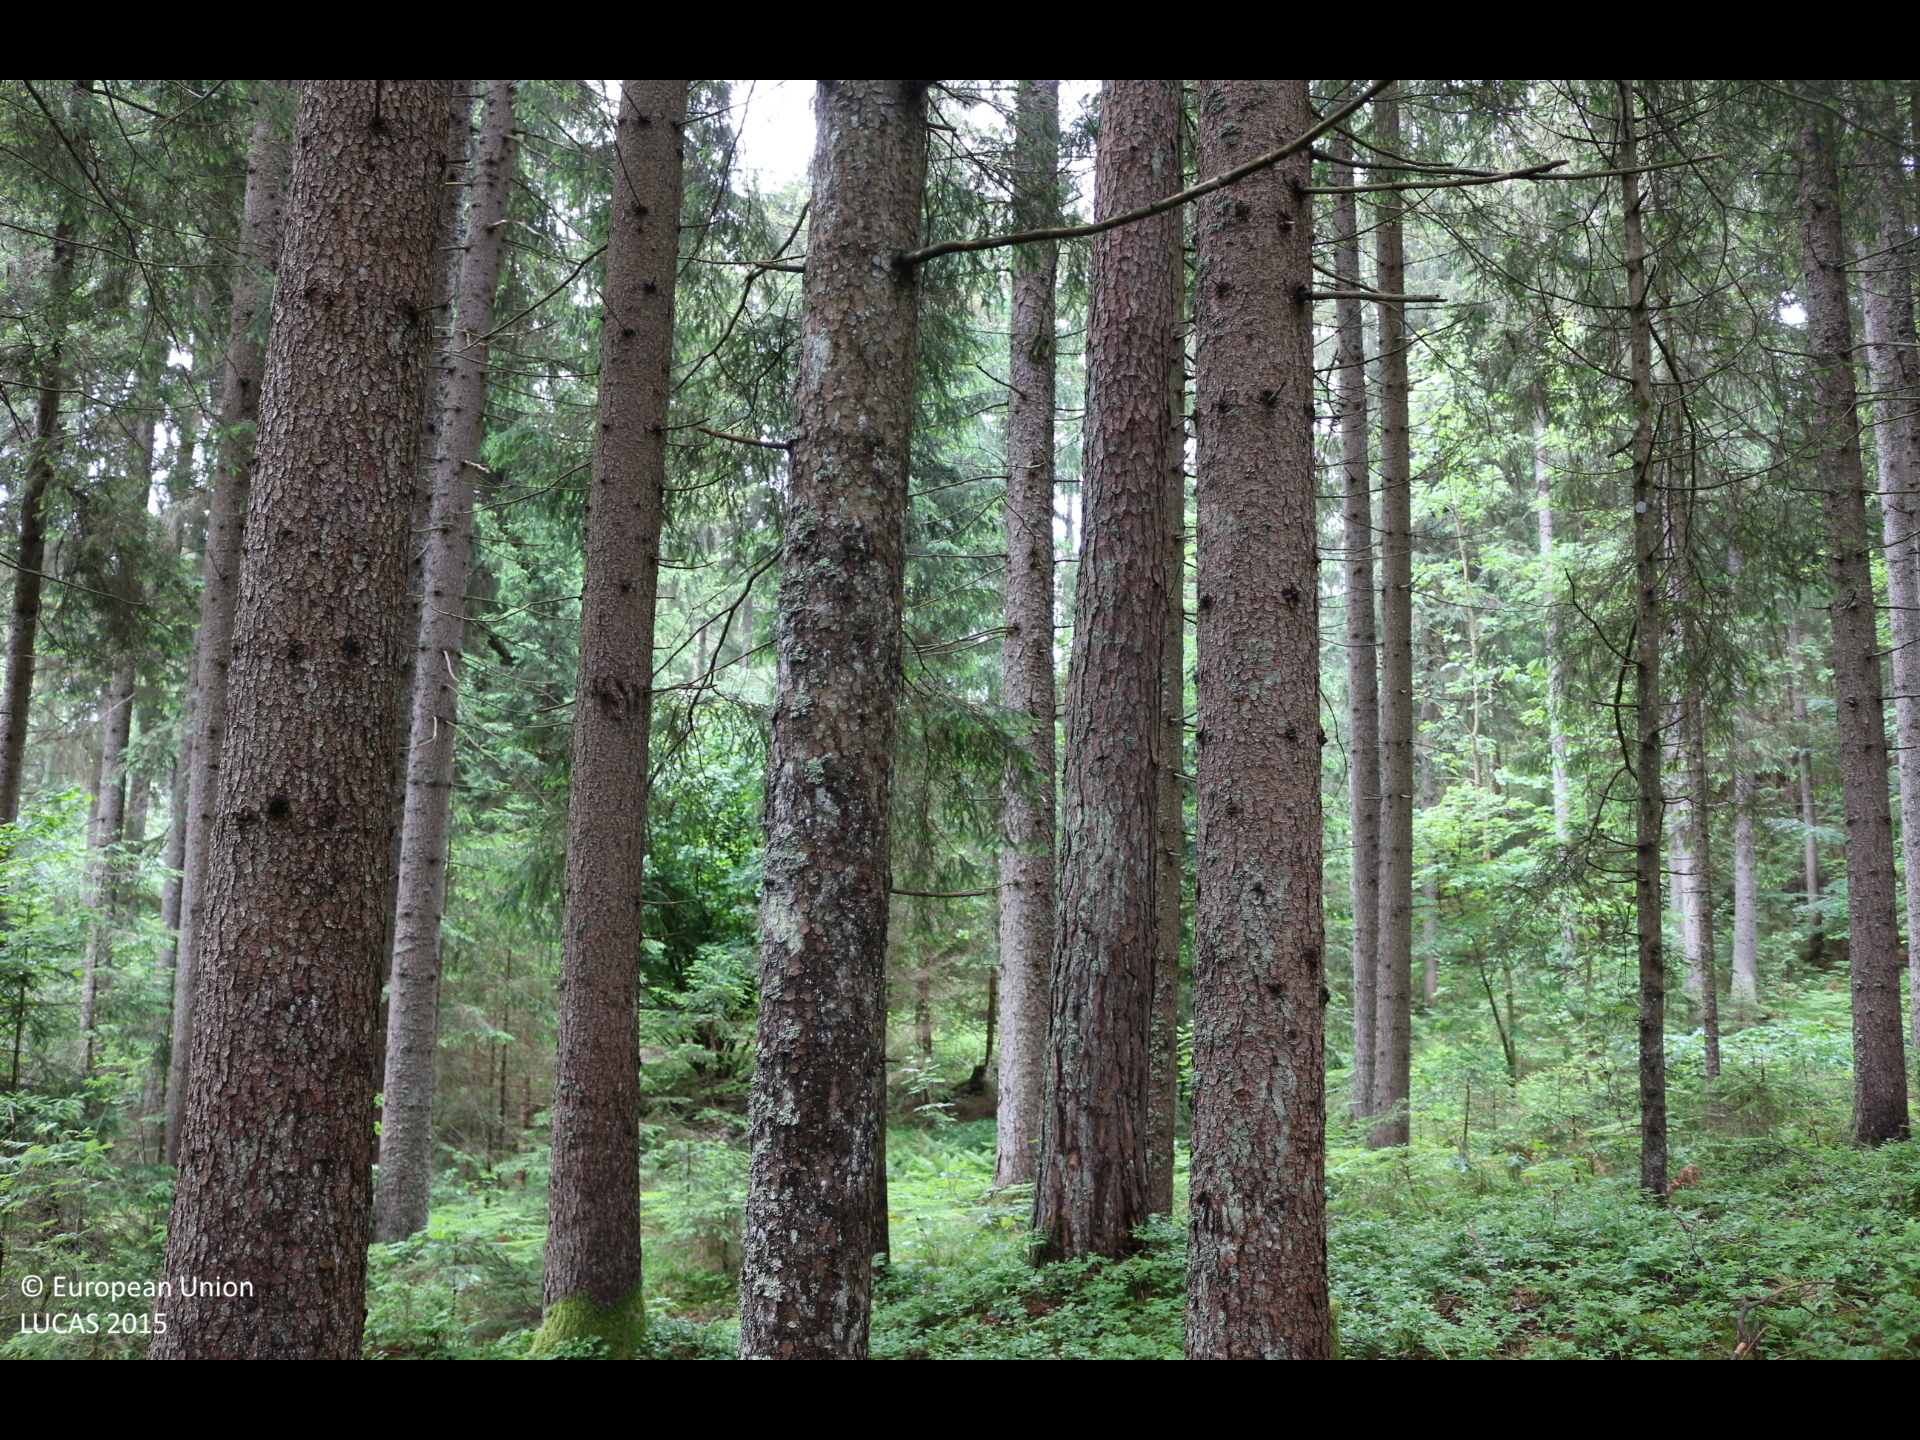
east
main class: Woodland
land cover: Spruce dominated coniferous woodland
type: alpine coniferous forest
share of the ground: > 75 %
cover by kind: coniferous forest trees 95 %, broadleaved forest trees 5 %
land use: Forestry
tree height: > 5 m
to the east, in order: Spruce dominated coniferous woodland; Tracks; Spruce dominated mixed woodland; Rivers and streams; Spruce dominated mixed woodland; Tracks; Spruce dominated coniferous woodland; Rivers and streams; Spruce dominated mixed woodland; Fences; Grassland without tree/shrub cover
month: May
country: AT
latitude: 46.6868
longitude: 14.1161
